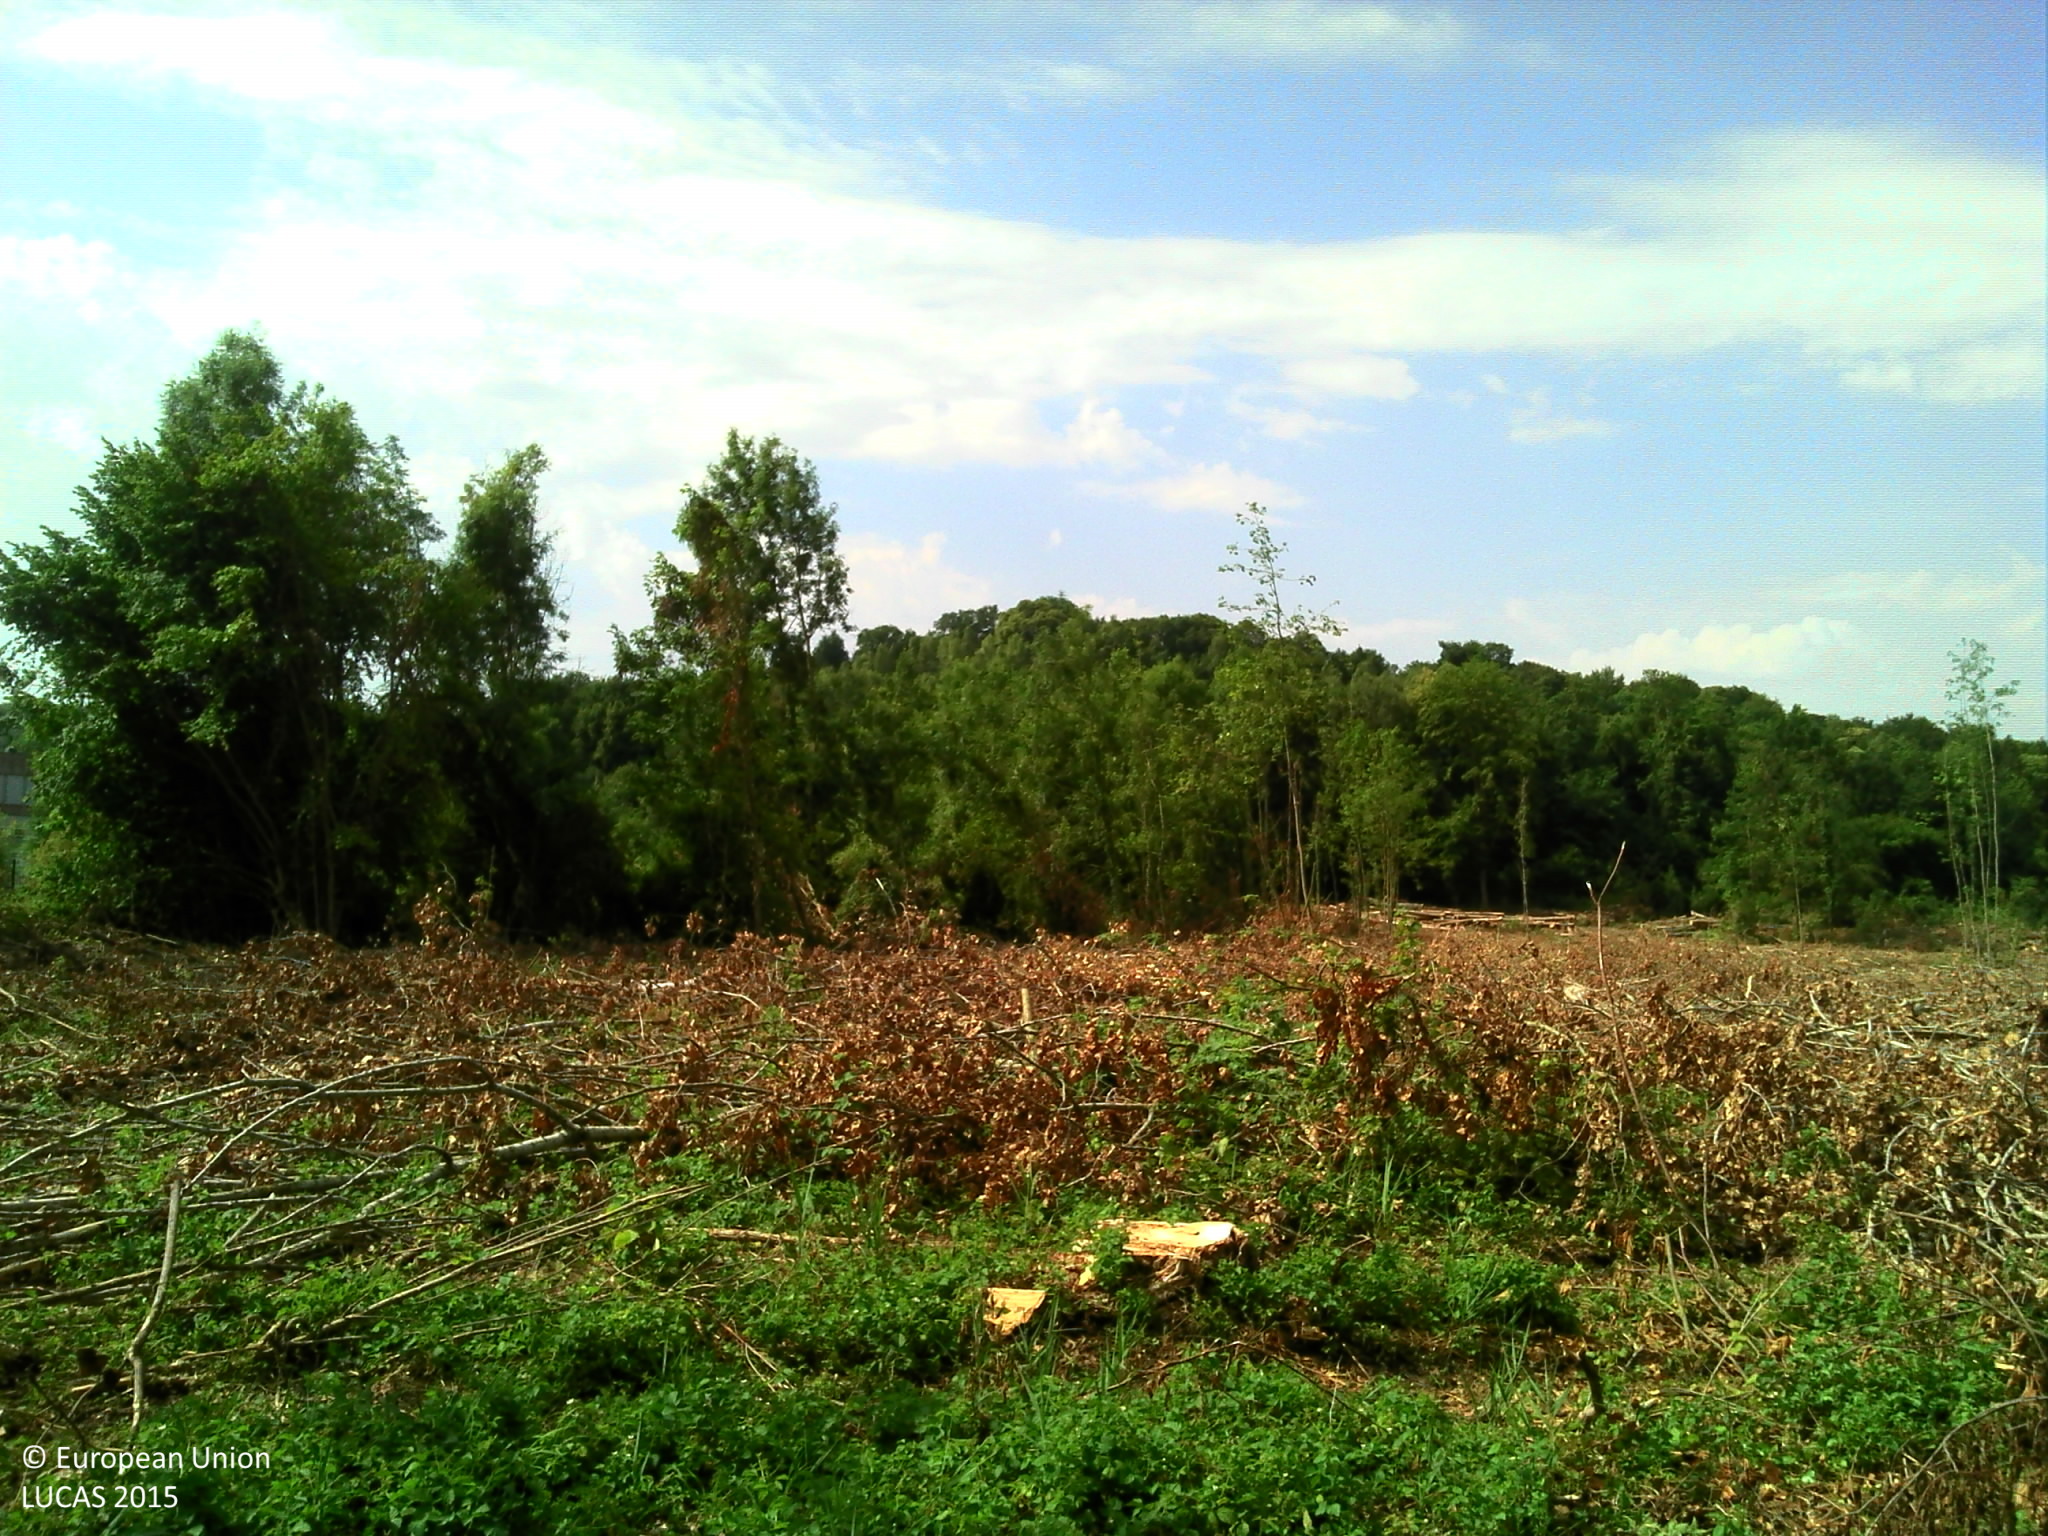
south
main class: Woodland
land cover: Broadleaved woodland
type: mesophytic deciduous forest
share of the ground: > 75 %
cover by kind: broadleaved forest trees 35 %, herbaceous plants 35 %, shrubs 30 %
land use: Forestry
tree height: > 5 m
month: July
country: FR
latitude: 49.3025
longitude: 2.4653
